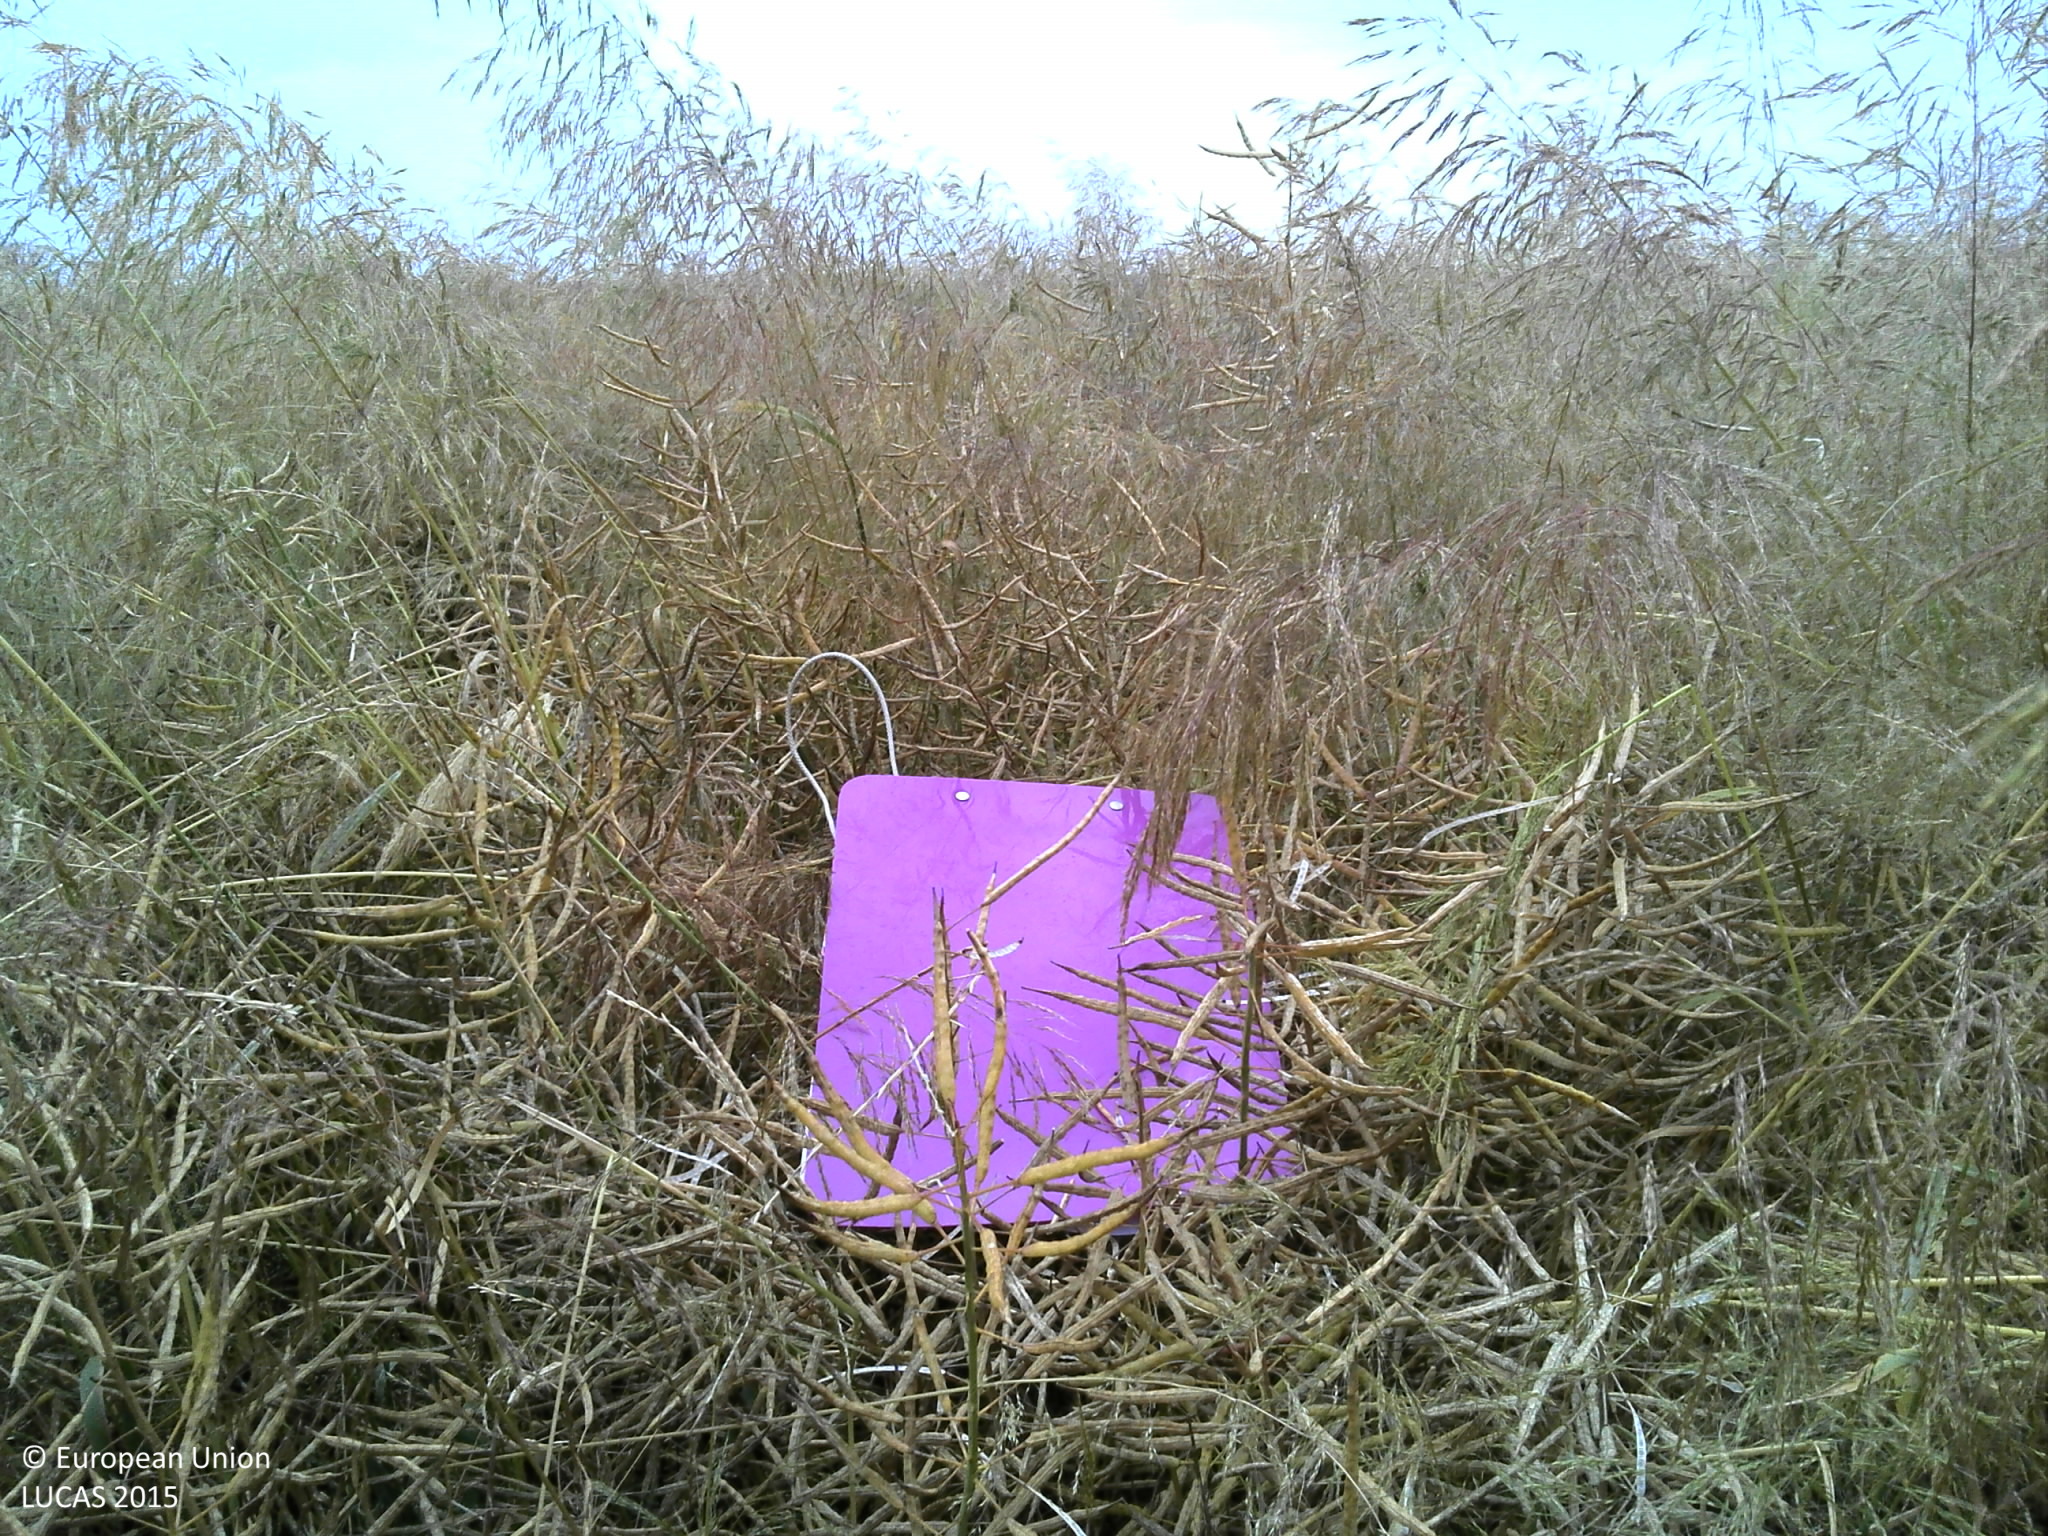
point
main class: Cropland
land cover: Rape and turnip rape
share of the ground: > 75 %
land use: Agriculture (excluding fallow land and kitchen gardens)
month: June
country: HR
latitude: 45.3470
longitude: 18.4418
